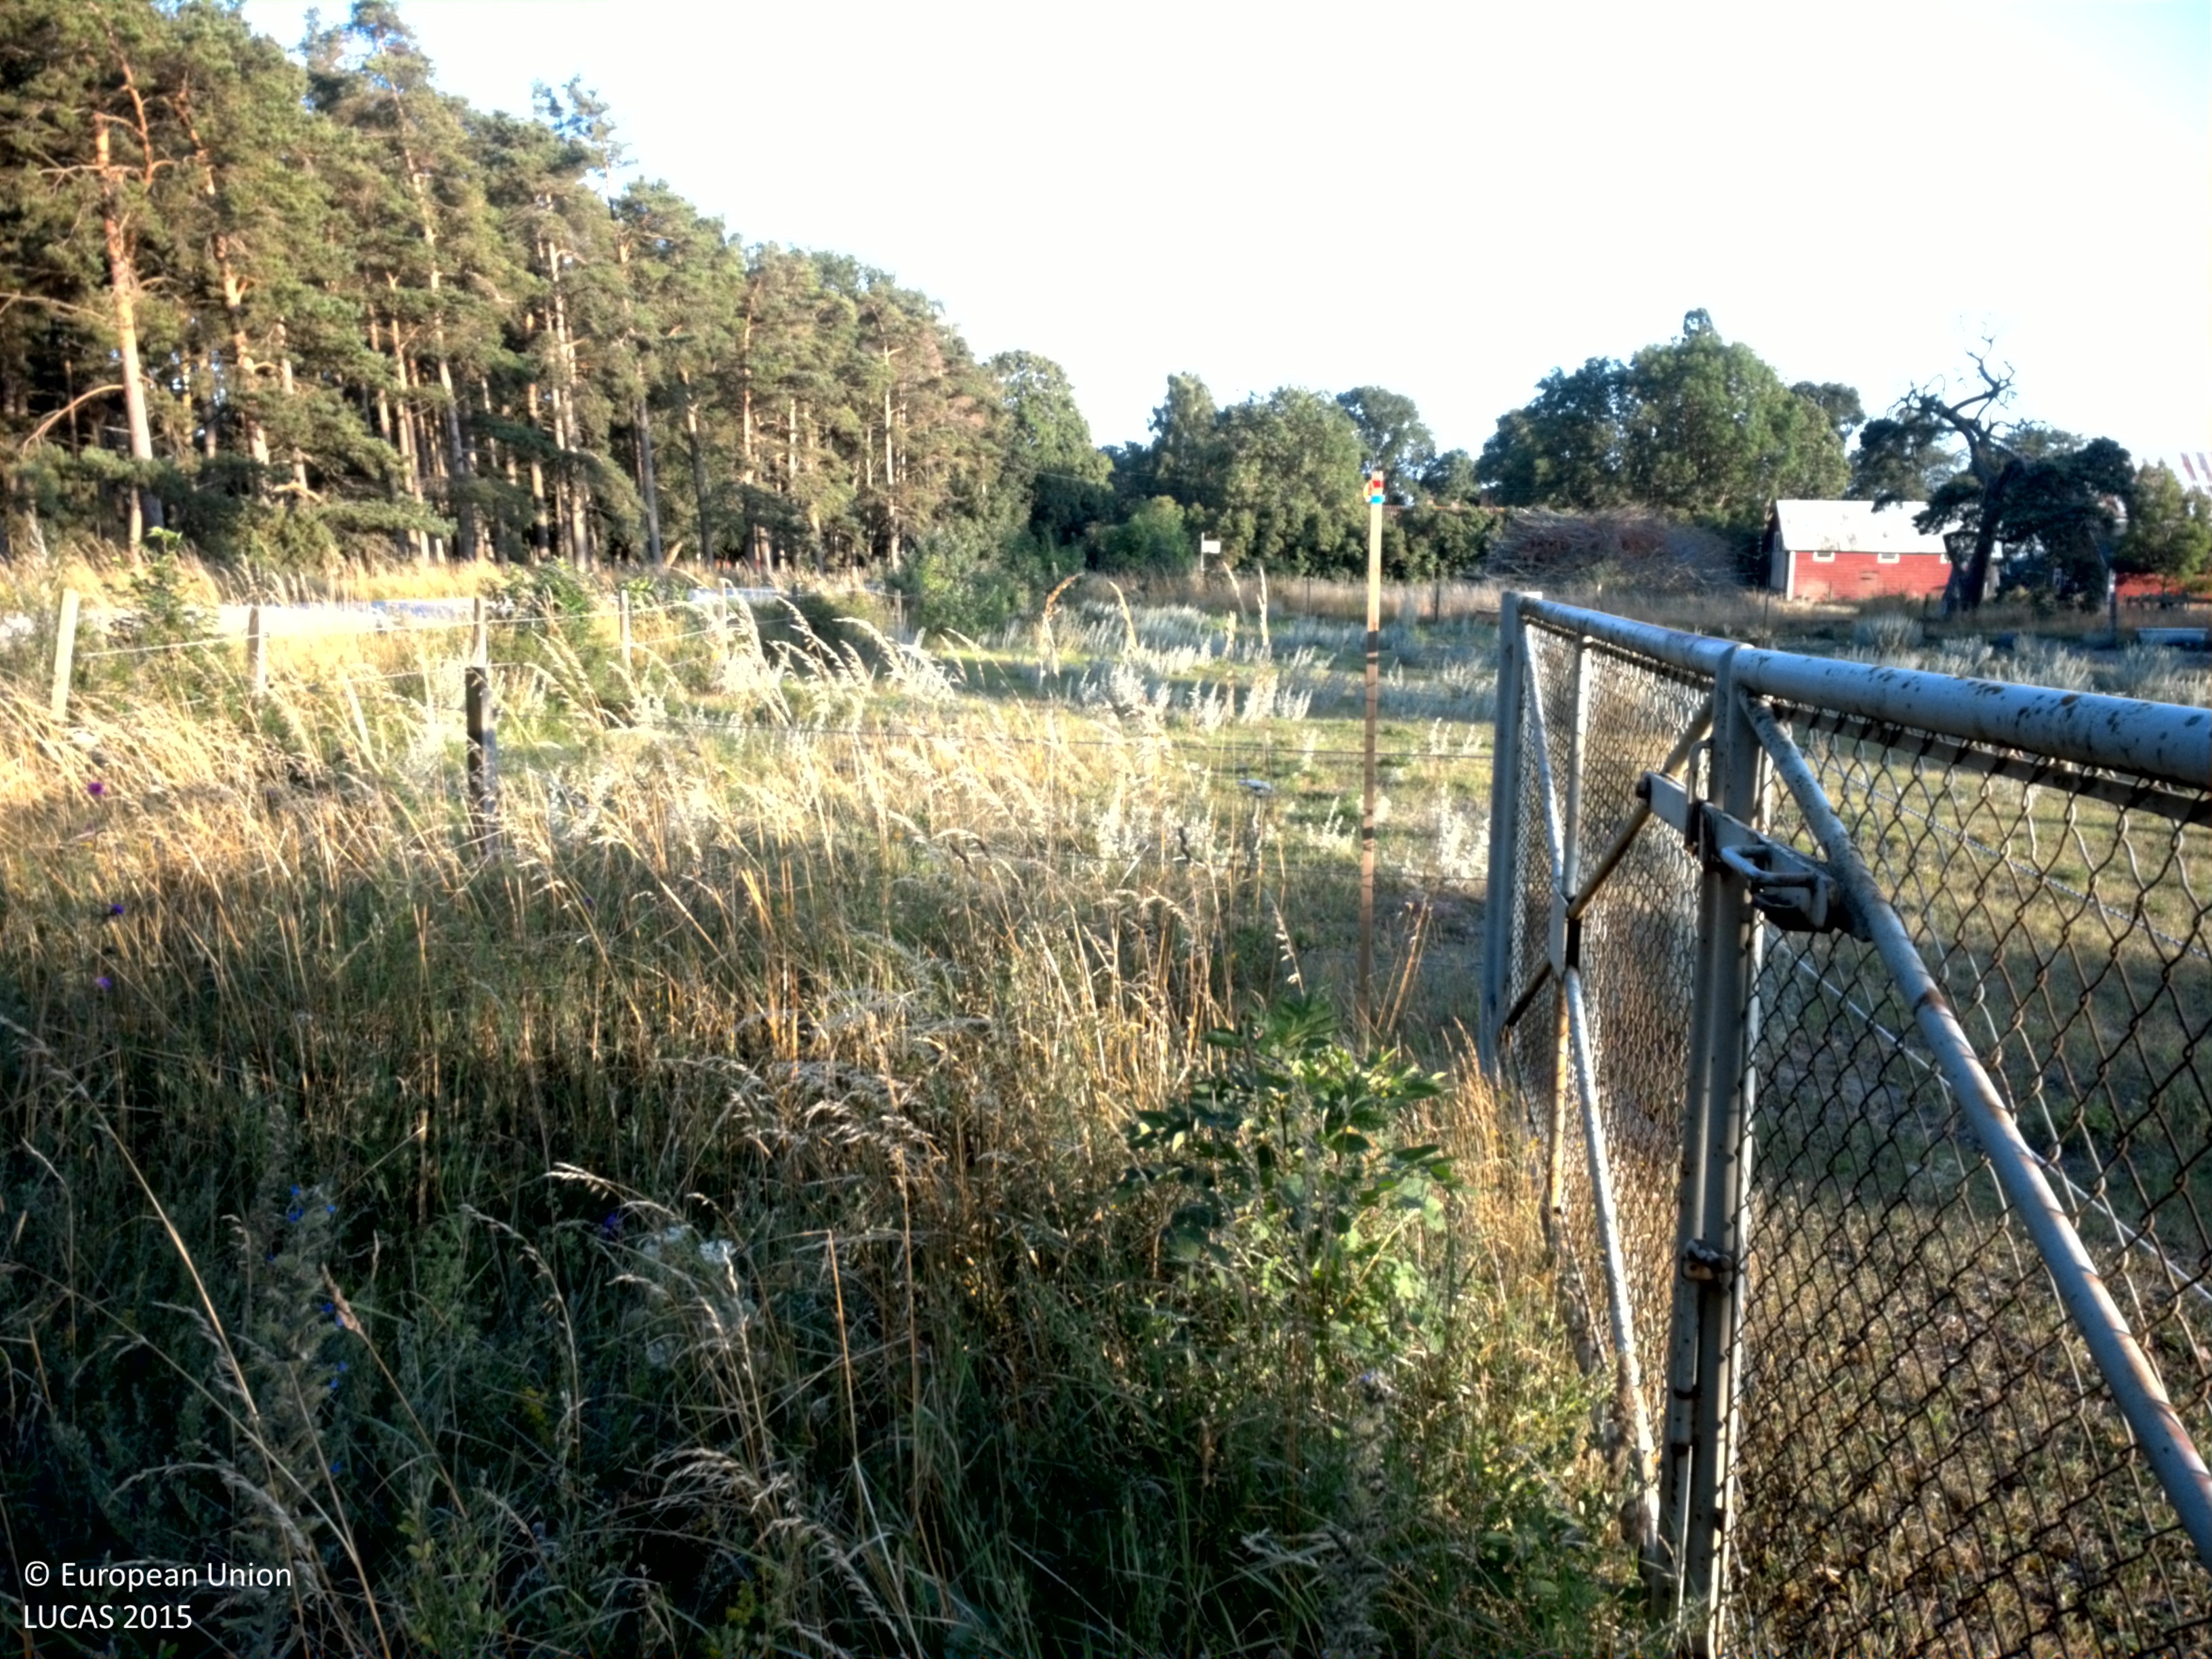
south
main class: Grassland
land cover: Grassland with sparse tree/shrub cover
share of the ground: > 75 %
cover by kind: herbaceous plants 90 %, coniferous forest trees 5 %, unconsolidated bare surface 5 %
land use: Agriculture (excluding fallow land and kitchen gardens)
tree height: > 5 m
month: July
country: SE
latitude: 57.2446
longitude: 18.2107
